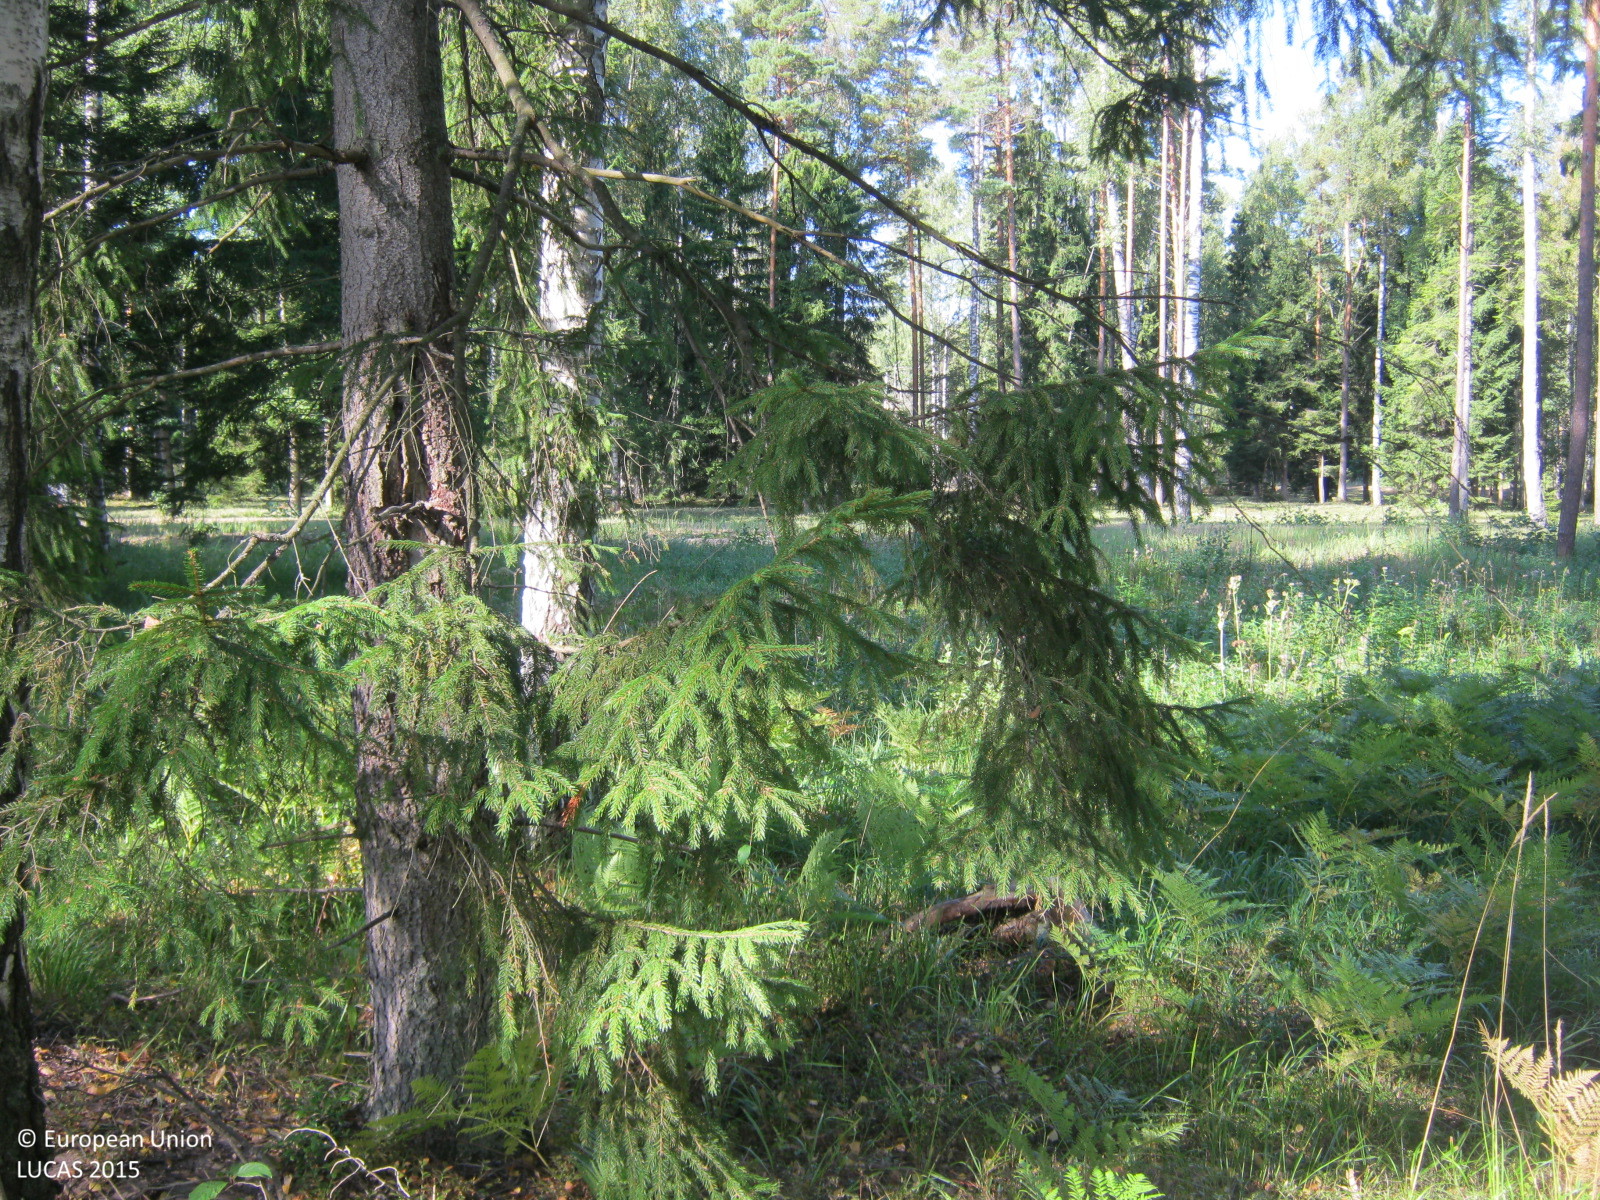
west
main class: Woodland
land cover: Spruce dominated mixed woodland
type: hemiboreal forest and nemoral coniferous forest and mixed broadleaved-coniferous forest
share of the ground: > 75 %
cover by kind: coniferous forest trees 50 %, broadleaved forest trees 30 %, herbaceous plants 20 %
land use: Forestry
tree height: > 5 m
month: September
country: LV
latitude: 57.3257
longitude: 24.4231
